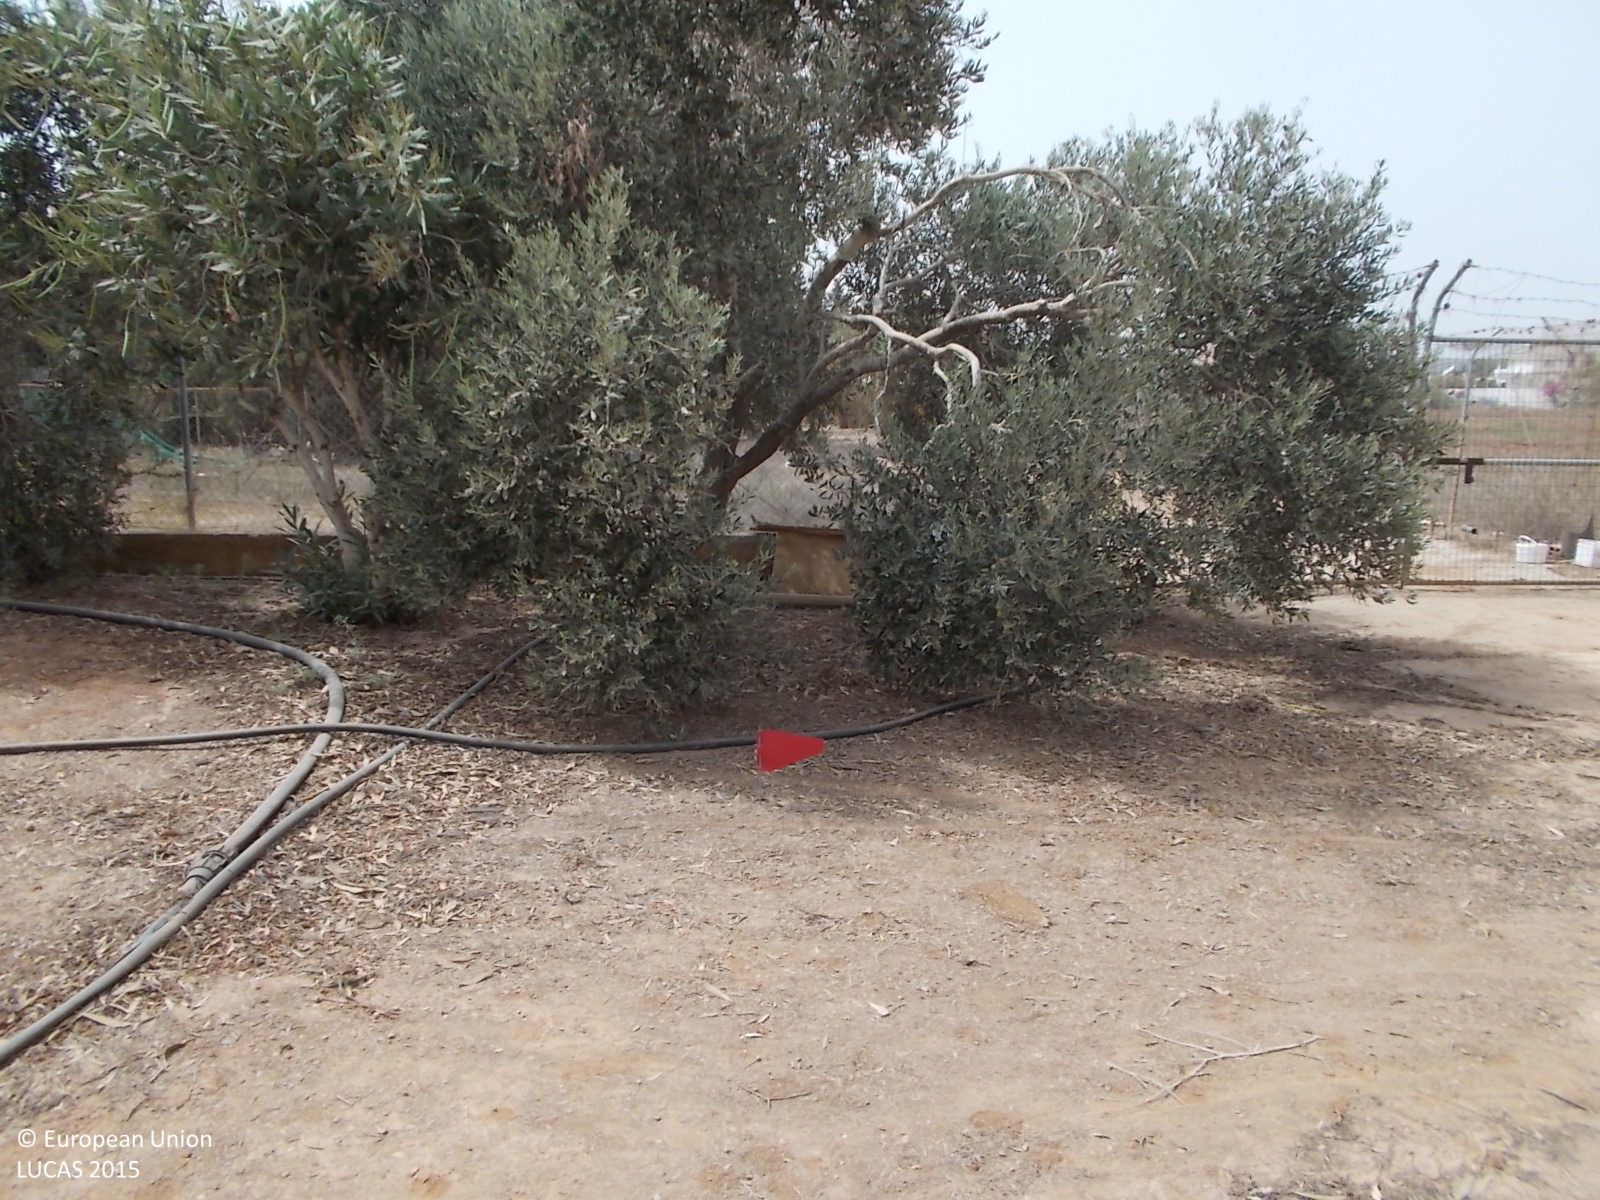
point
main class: Cropland
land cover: Olive groves
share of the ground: > 75 %
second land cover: Other bare soil
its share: > 75 %
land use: Agriculture (excluding fallow land and kitchen gardens)
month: March
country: CY
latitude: 34.9845
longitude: 34.0658
